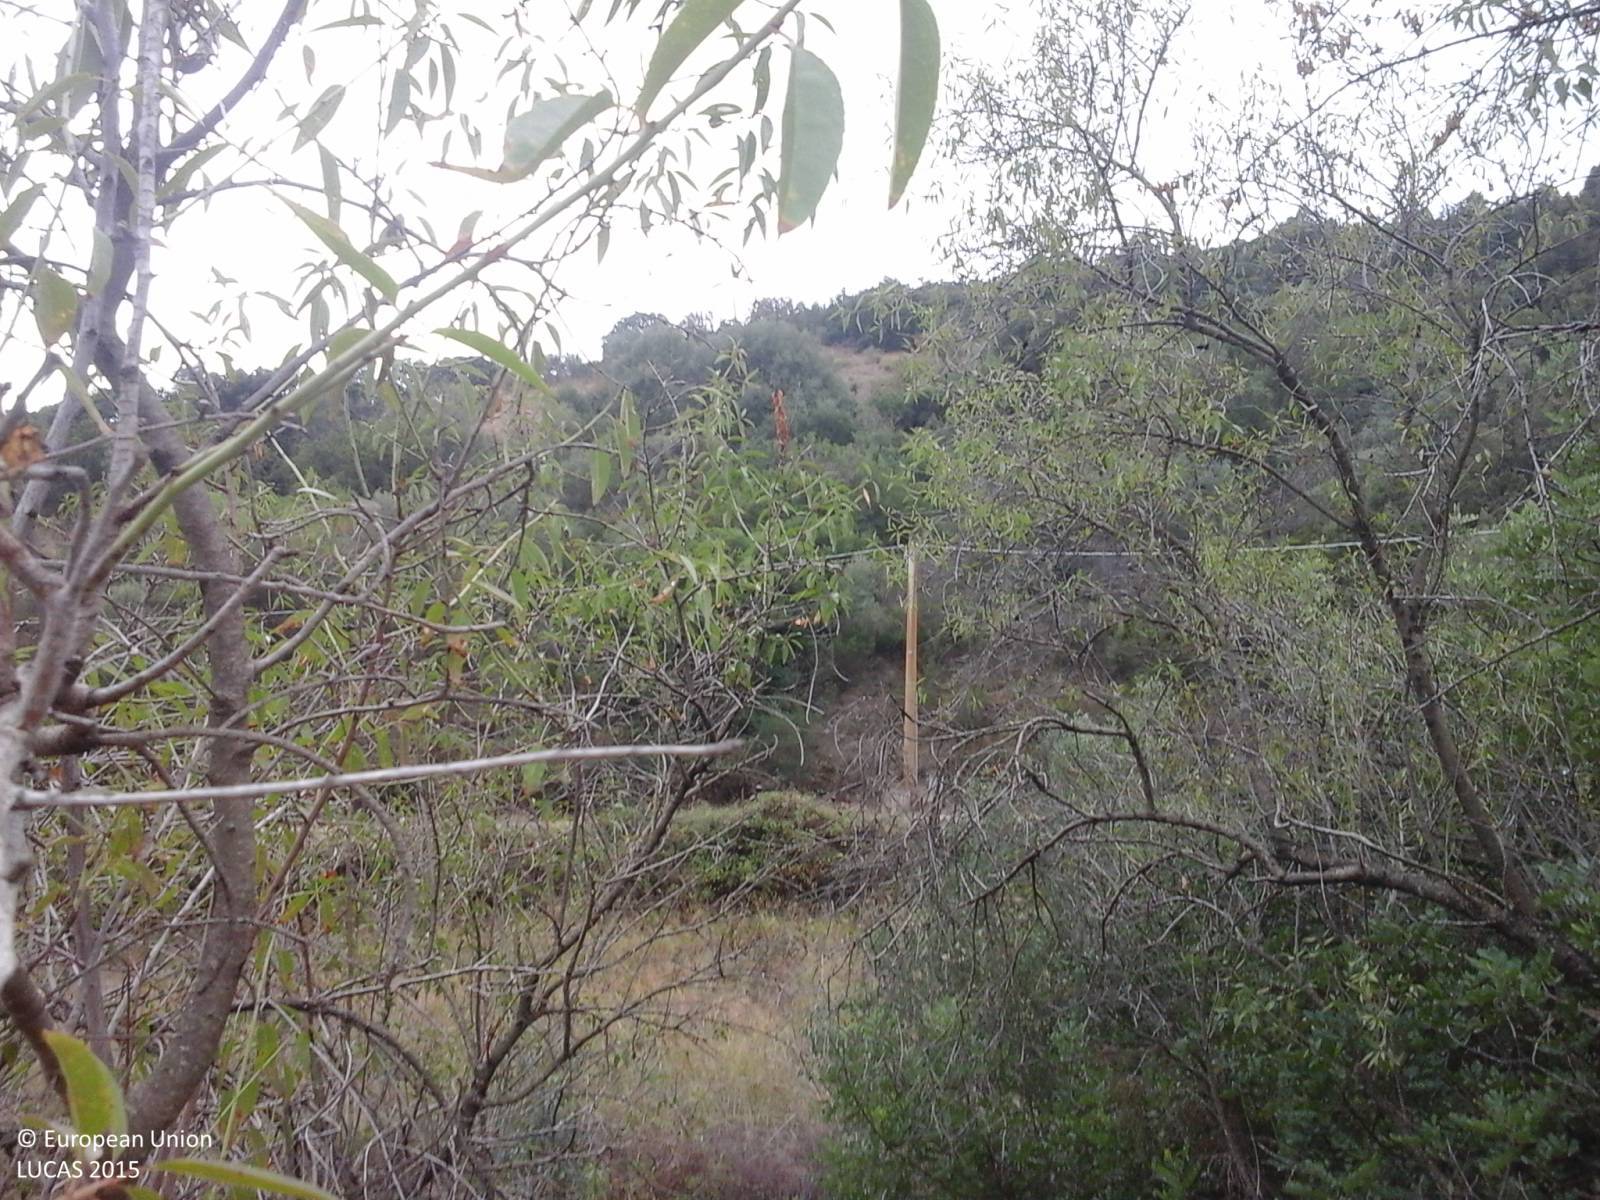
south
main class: Grassland
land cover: Spontaneously vegetated surfaces
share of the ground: > 75 %
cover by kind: herbaceous plants 80 %, unconsolidated bare surface 15 %, consolidated bare surface 5 %
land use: Agriculture (excluding fallow land and kitchen gardens)
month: September
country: IT
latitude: 39.7776
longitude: 9.5937
